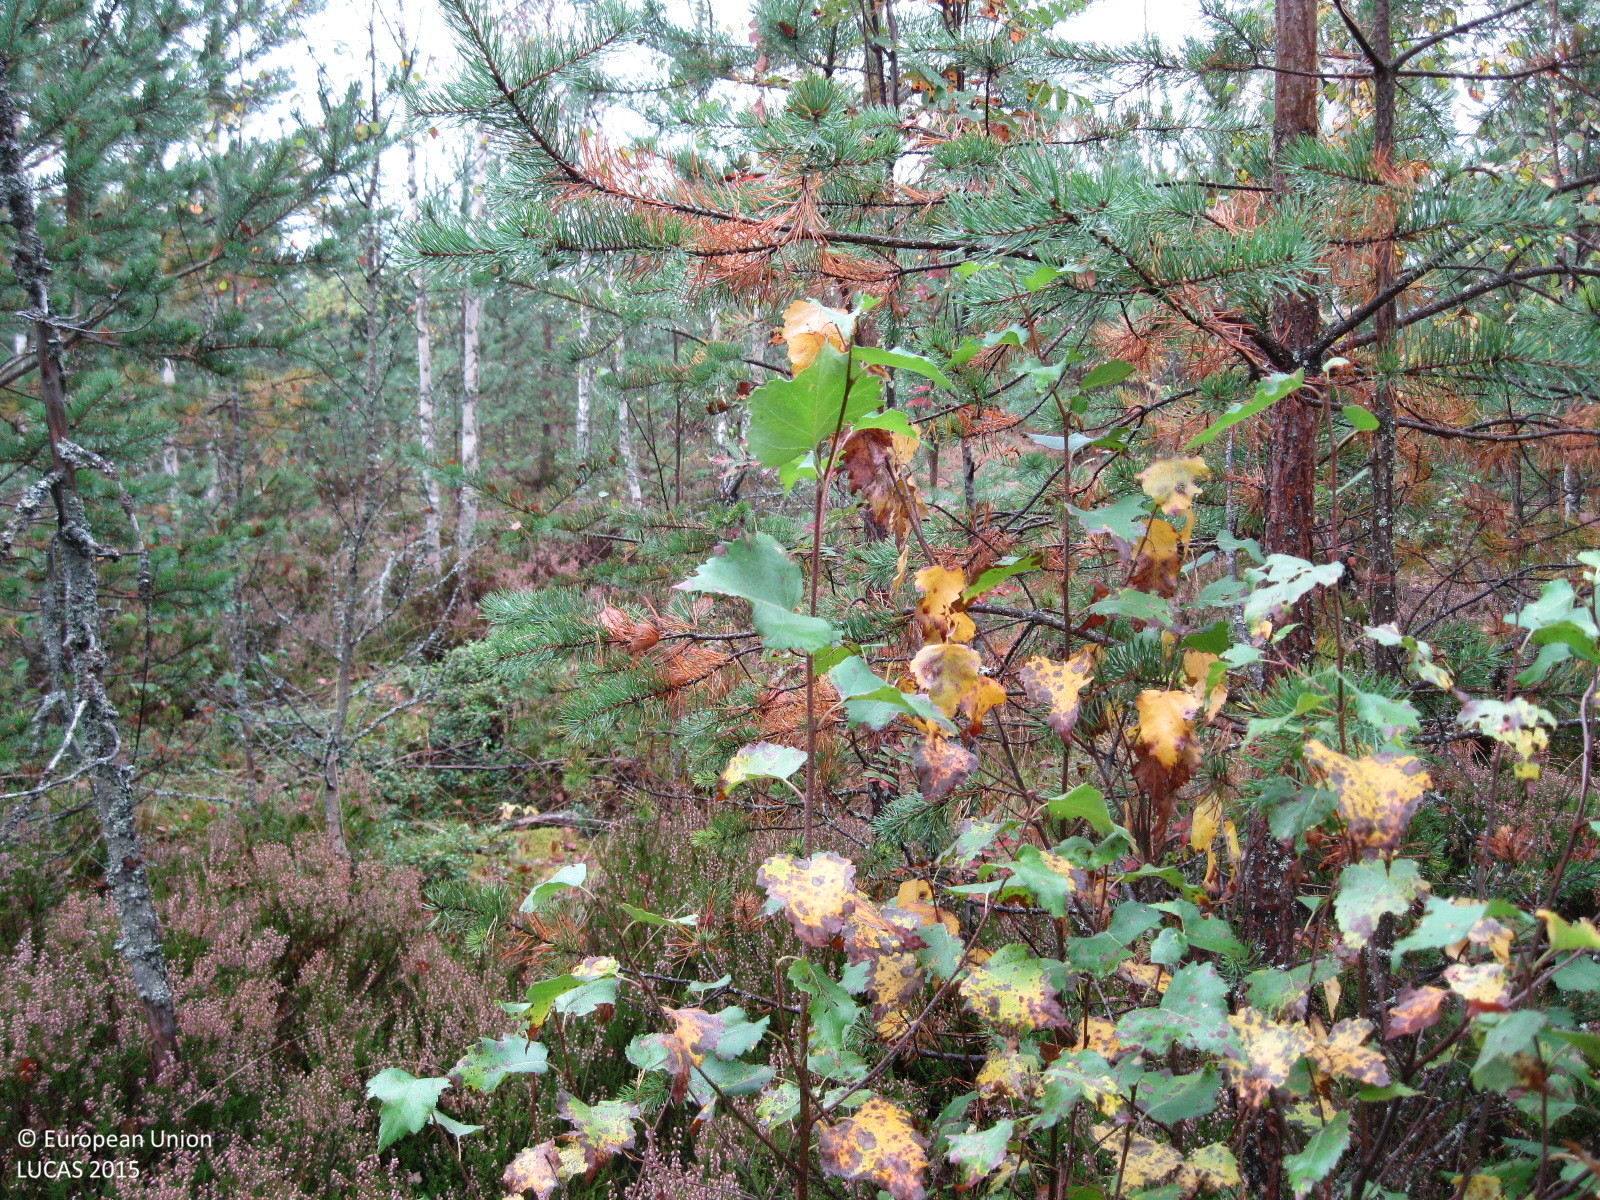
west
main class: Woodland
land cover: Pine dominated mixed woodland
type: boreal forest
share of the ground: 50 - 75 %
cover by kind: coniferous forest trees 50 %, shrubs 30 %, broadleaved forest trees 20 %
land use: Forestry
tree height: > 5 m
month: September
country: FI
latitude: 60.8774
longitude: 25.0166
